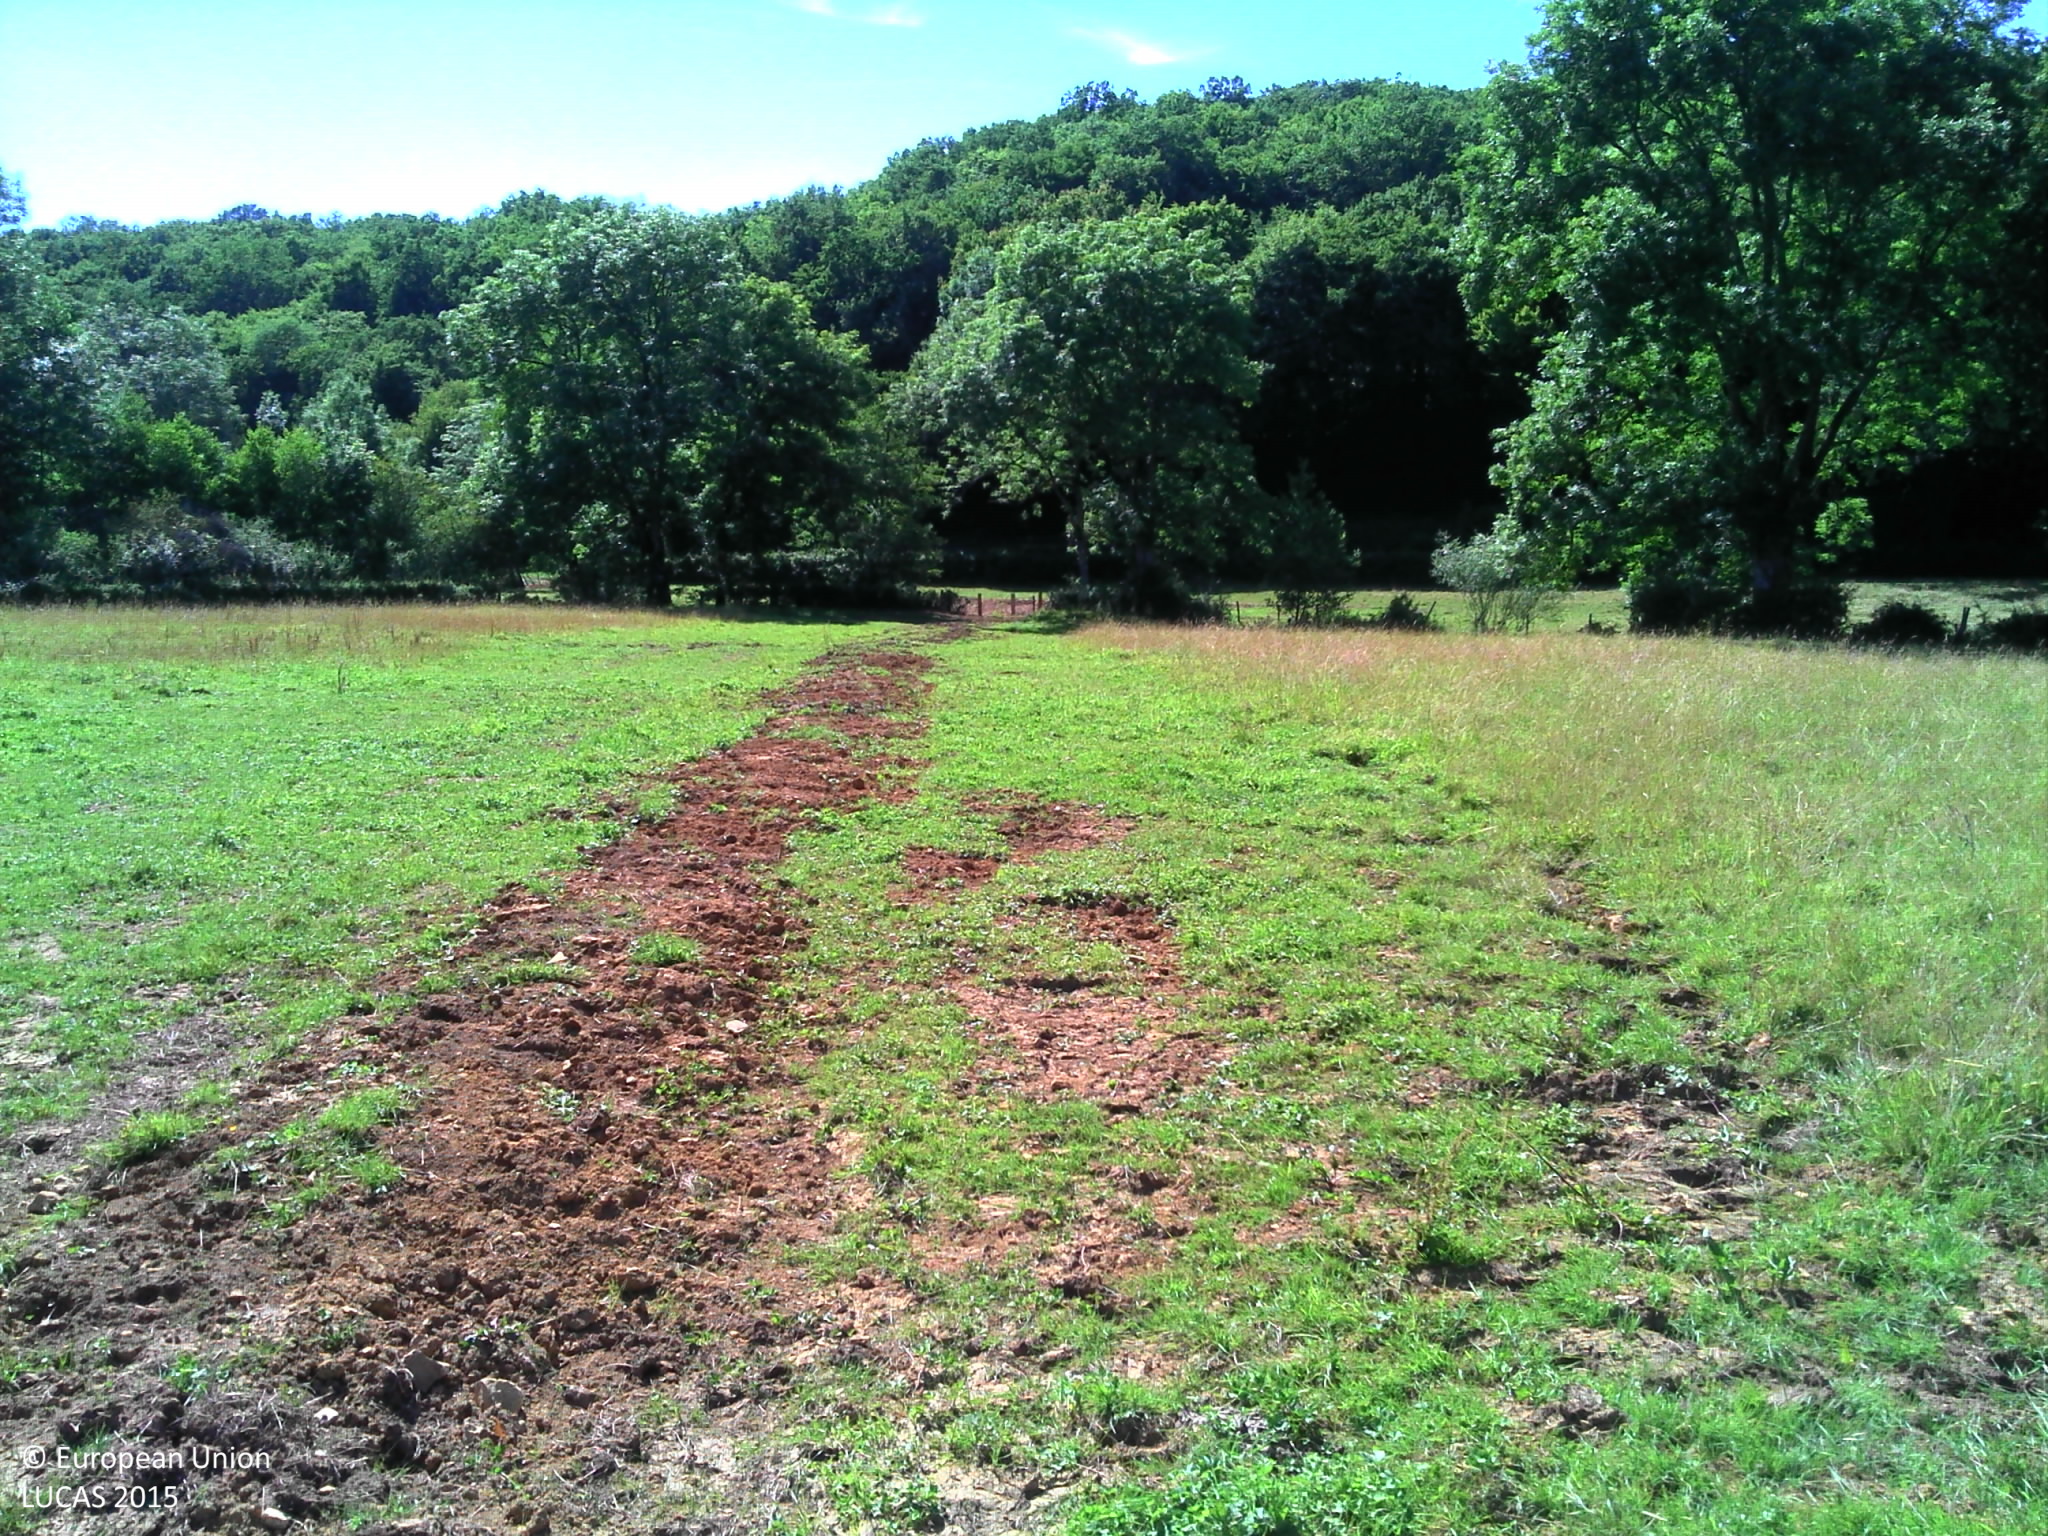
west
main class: Grassland
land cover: Grassland without tree/shrub cover
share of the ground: > 75 %
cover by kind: herbaceous plants 100 %
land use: Agriculture (excluding fallow land and kitchen gardens)
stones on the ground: < 10 %
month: June
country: FR
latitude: 47.3634
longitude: 3.4952
